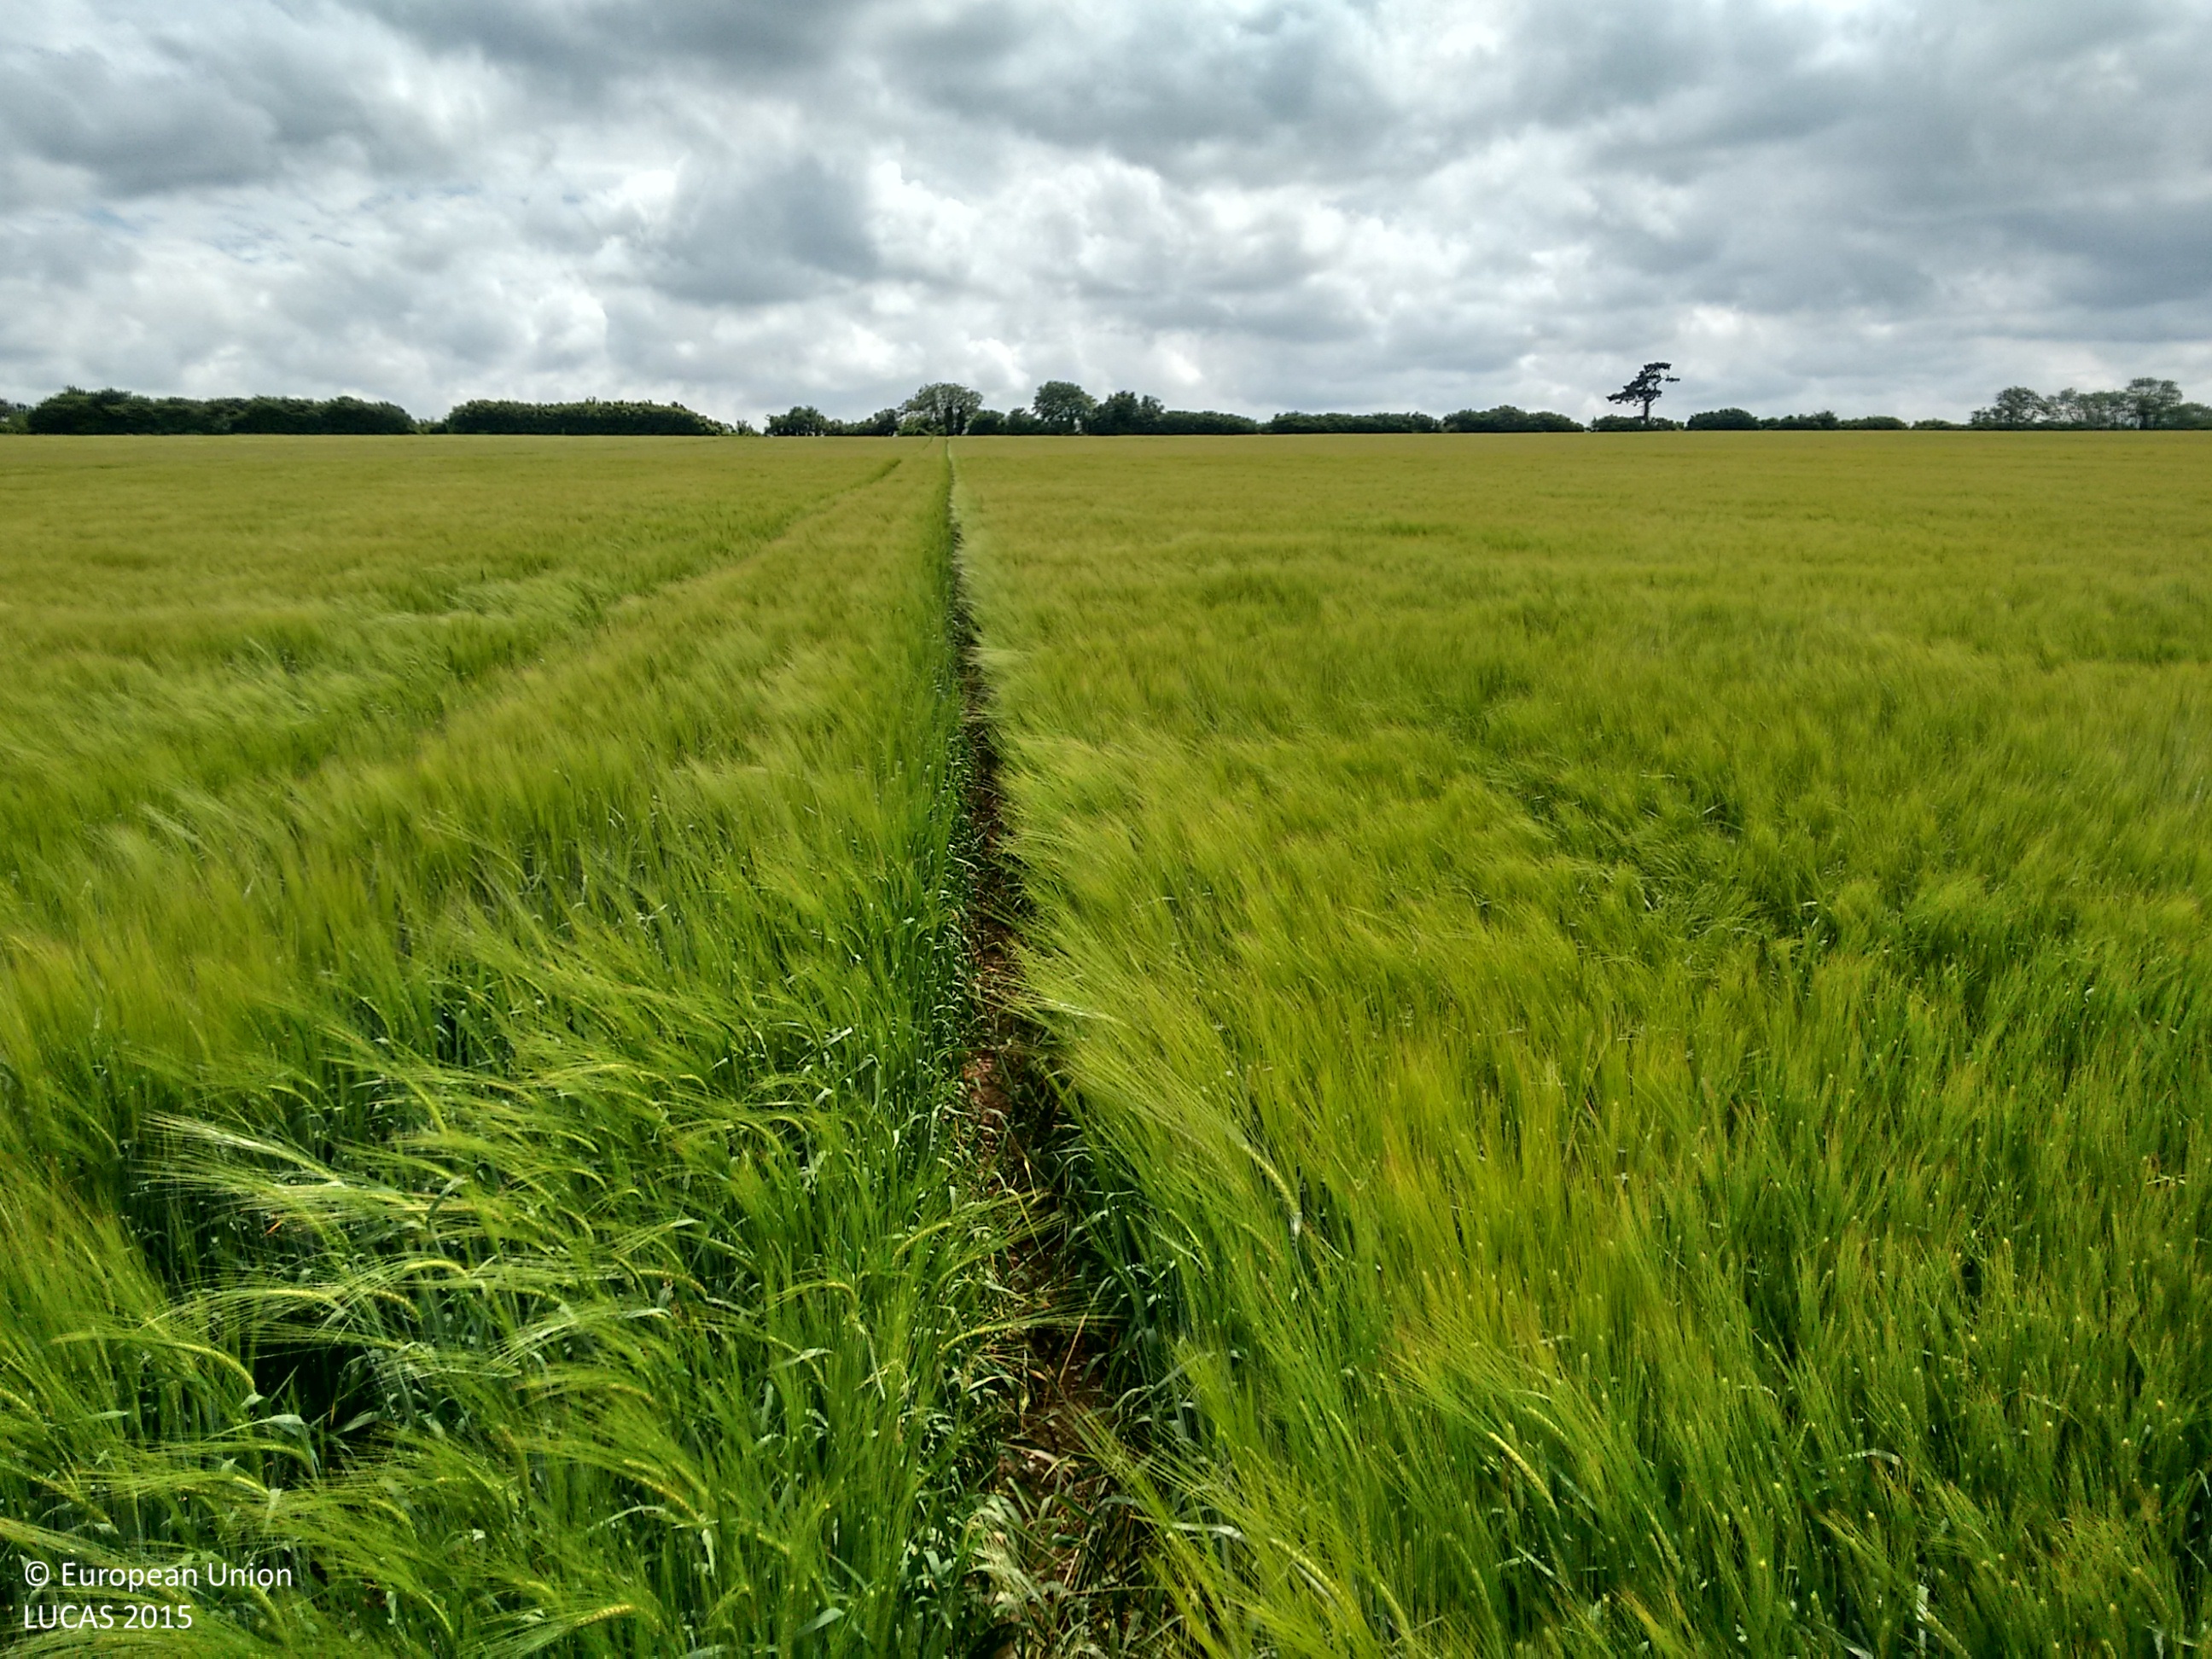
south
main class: Cropland
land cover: Barley
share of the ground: > 75 %
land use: Agriculture (excluding fallow land and kitchen gardens)
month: June
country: GB
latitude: 51.3774
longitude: -1.5307
